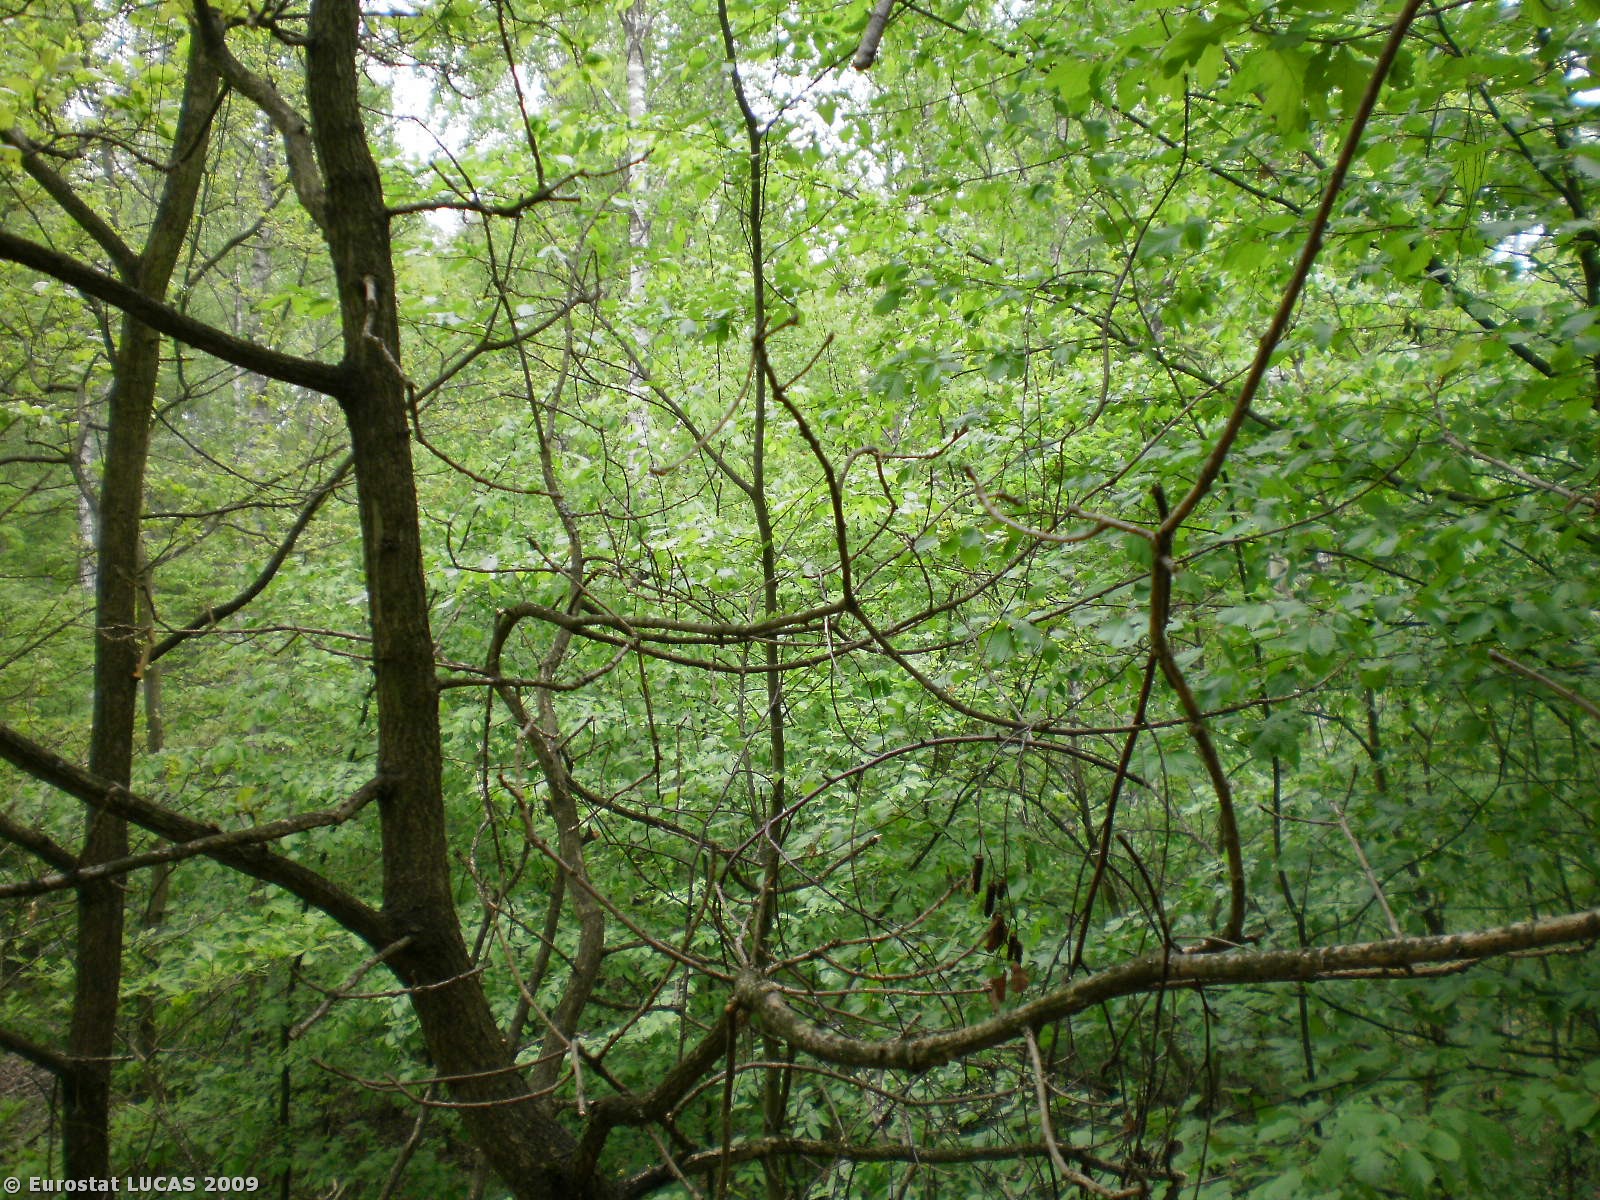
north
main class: Woodland
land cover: Broadleaved woodland
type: mesophytic deciduous forest
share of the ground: > 75 %
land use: Forestry
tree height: > 5 m
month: May
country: PL
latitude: 53.6190
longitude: 18.8649
